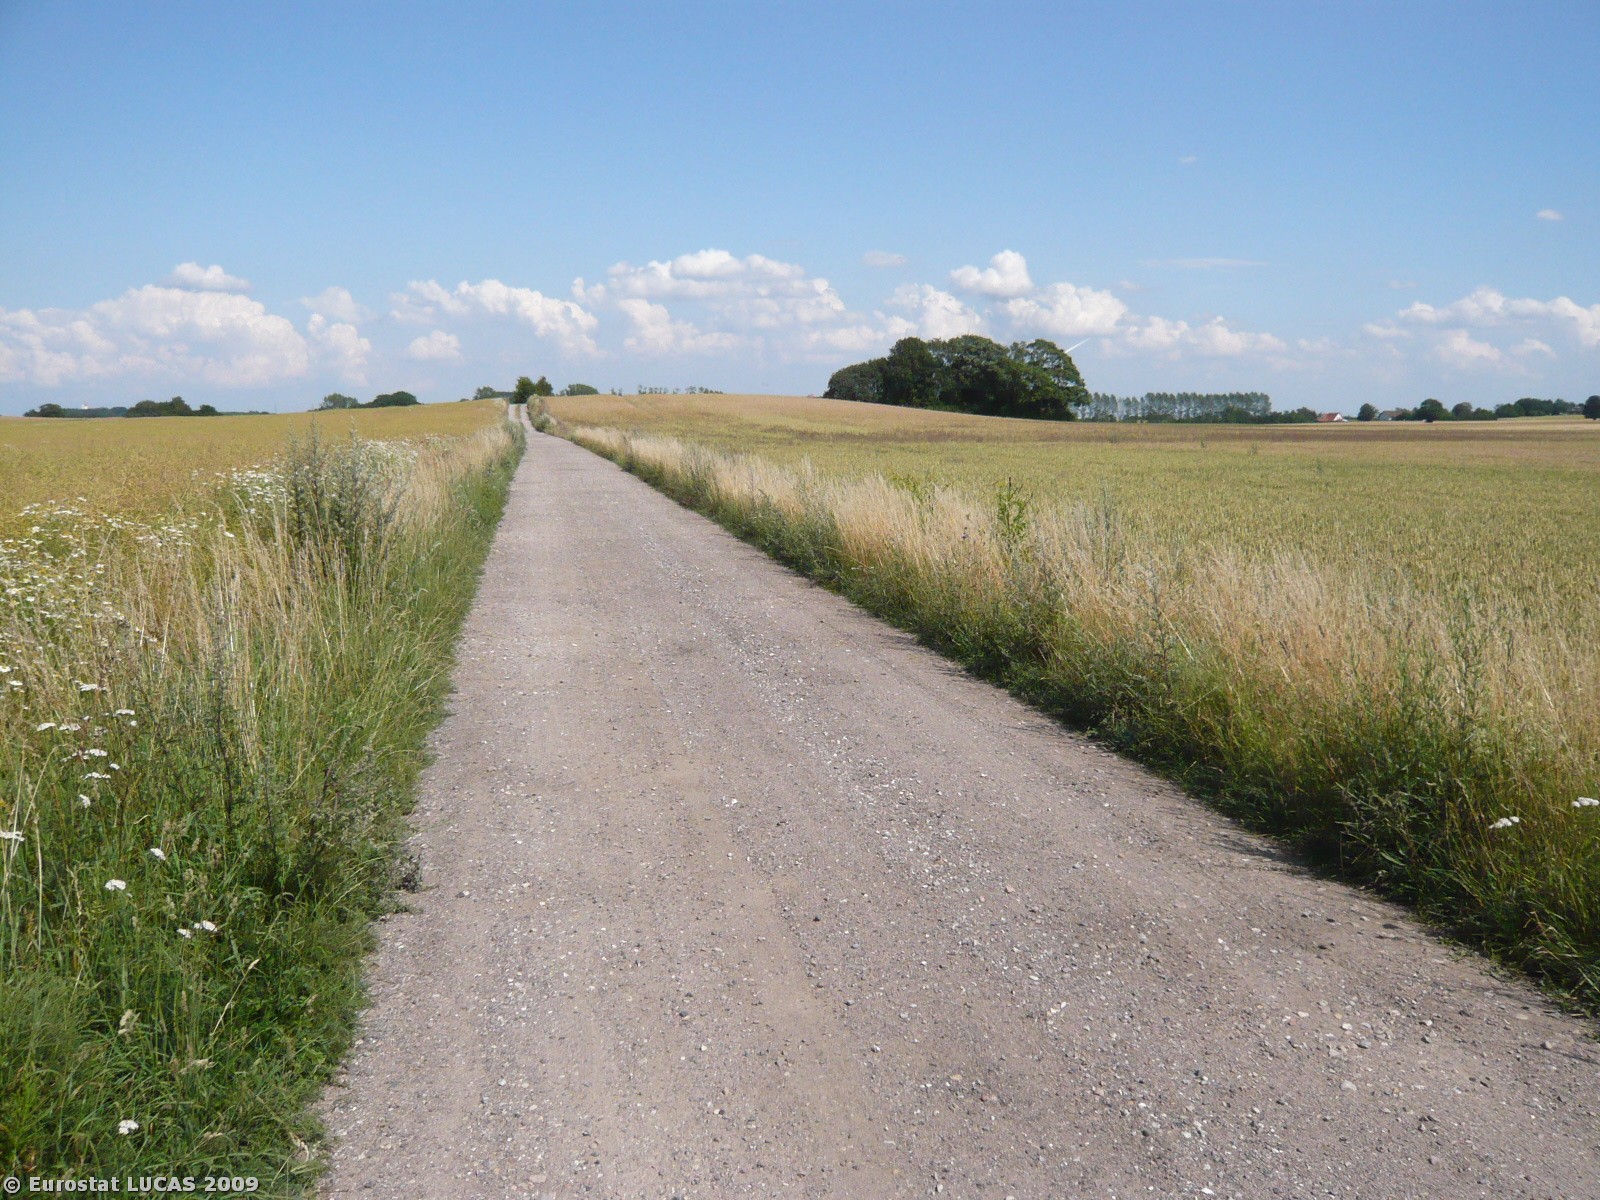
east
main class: Cropland
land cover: Rape and turnip rape
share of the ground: > 75 %
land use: Agriculture (excluding fallow land and kitchen gardens)
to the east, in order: Rape and turnip rape; Tracks; Fences; Grassland without tree/shrub cover; Fences; Arable land (only in case pi)
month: July
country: DK
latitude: 55.6938
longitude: 11.4781
